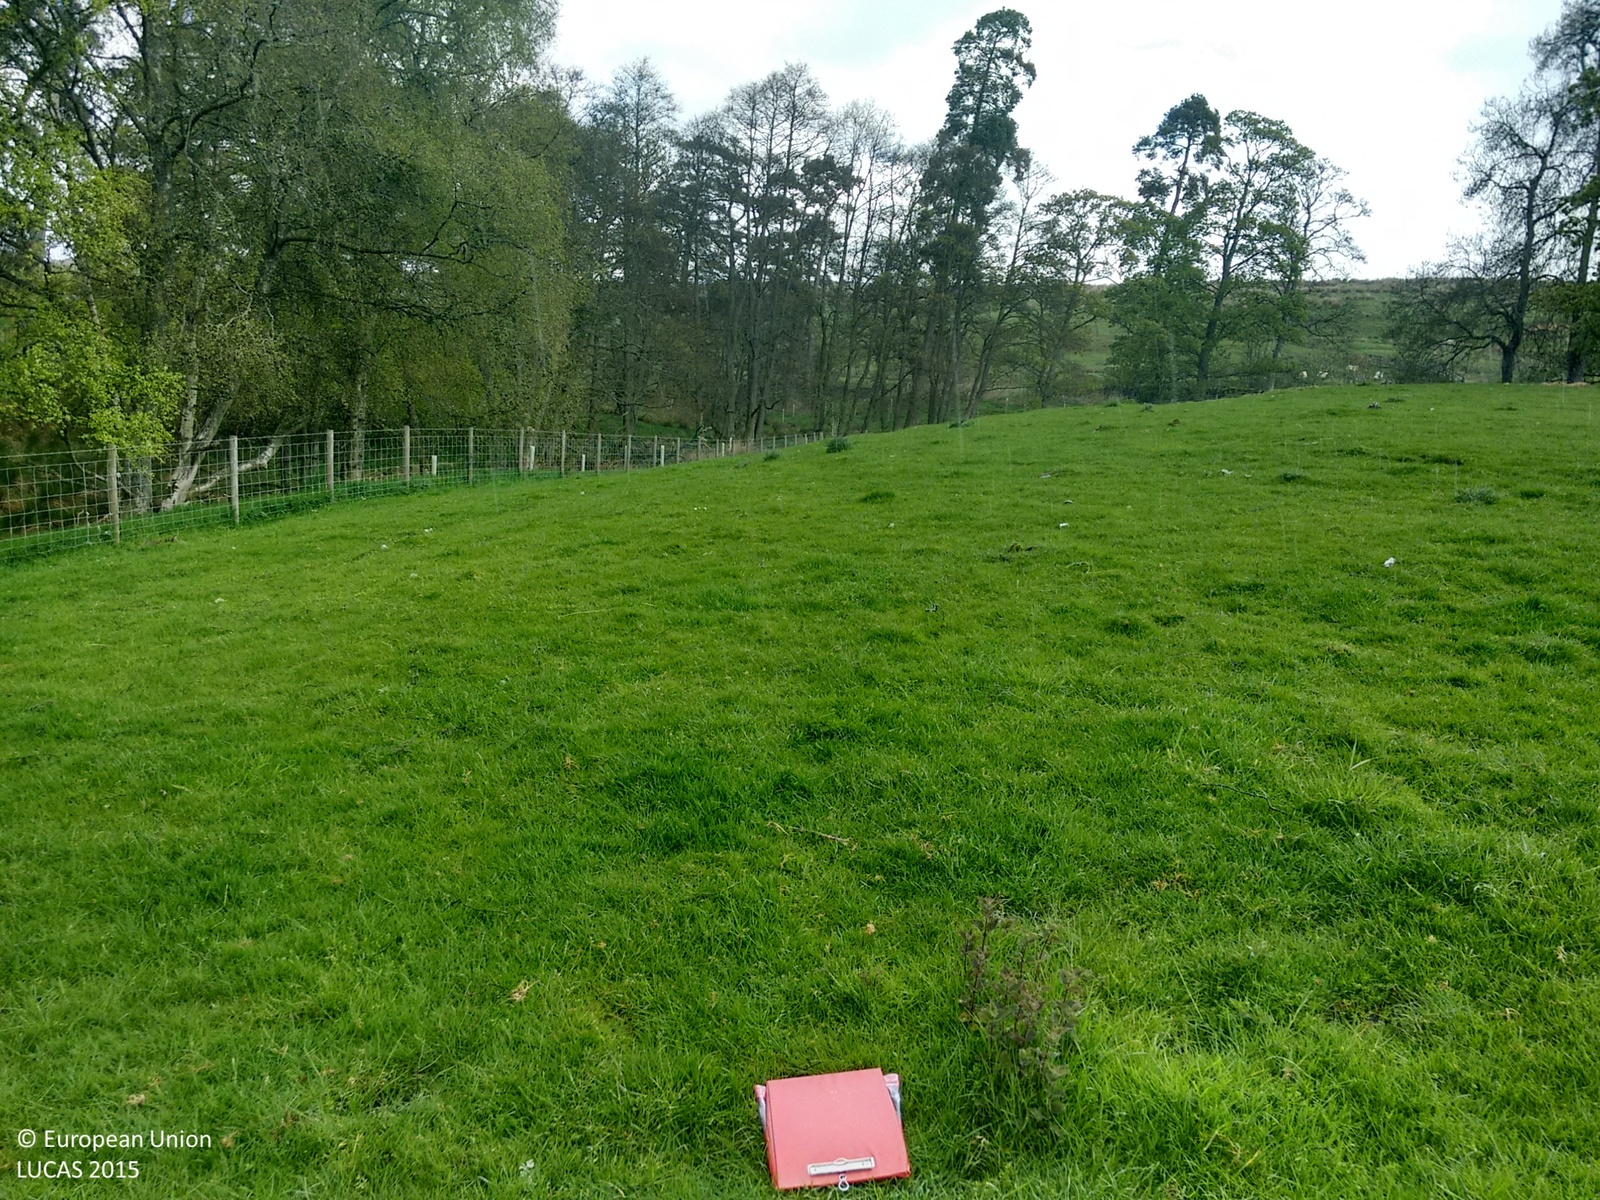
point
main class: Grassland
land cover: Grassland without tree/shrub cover
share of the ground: > 75 %
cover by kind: herbaceous plants 100 %
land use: Agriculture (excluding fallow land and kitchen gardens)
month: May
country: GB
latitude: 55.2699
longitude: -2.2554
